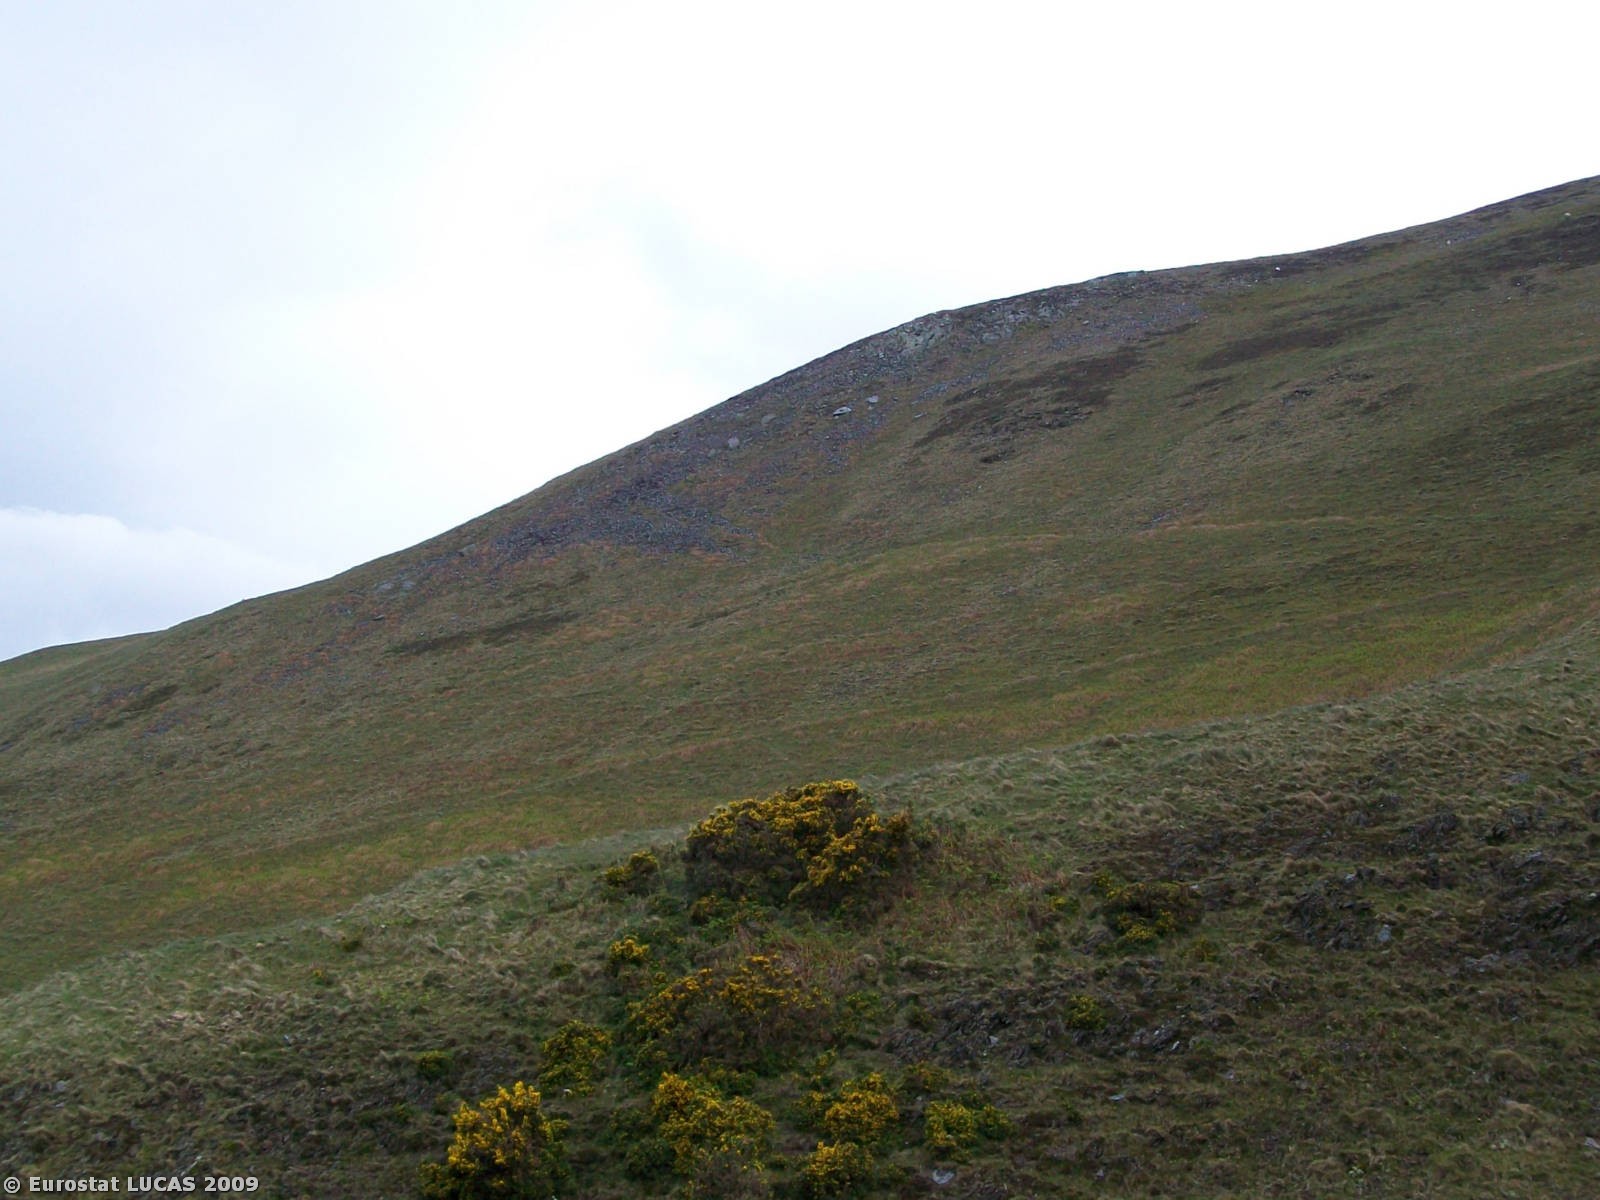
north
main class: Grassland
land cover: Grassland without tree/shrub cover
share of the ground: > 75 %
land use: Agriculture (excluding fallow land and kitchen gardens)
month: May
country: GB
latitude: 54.6862
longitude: -3.1515
